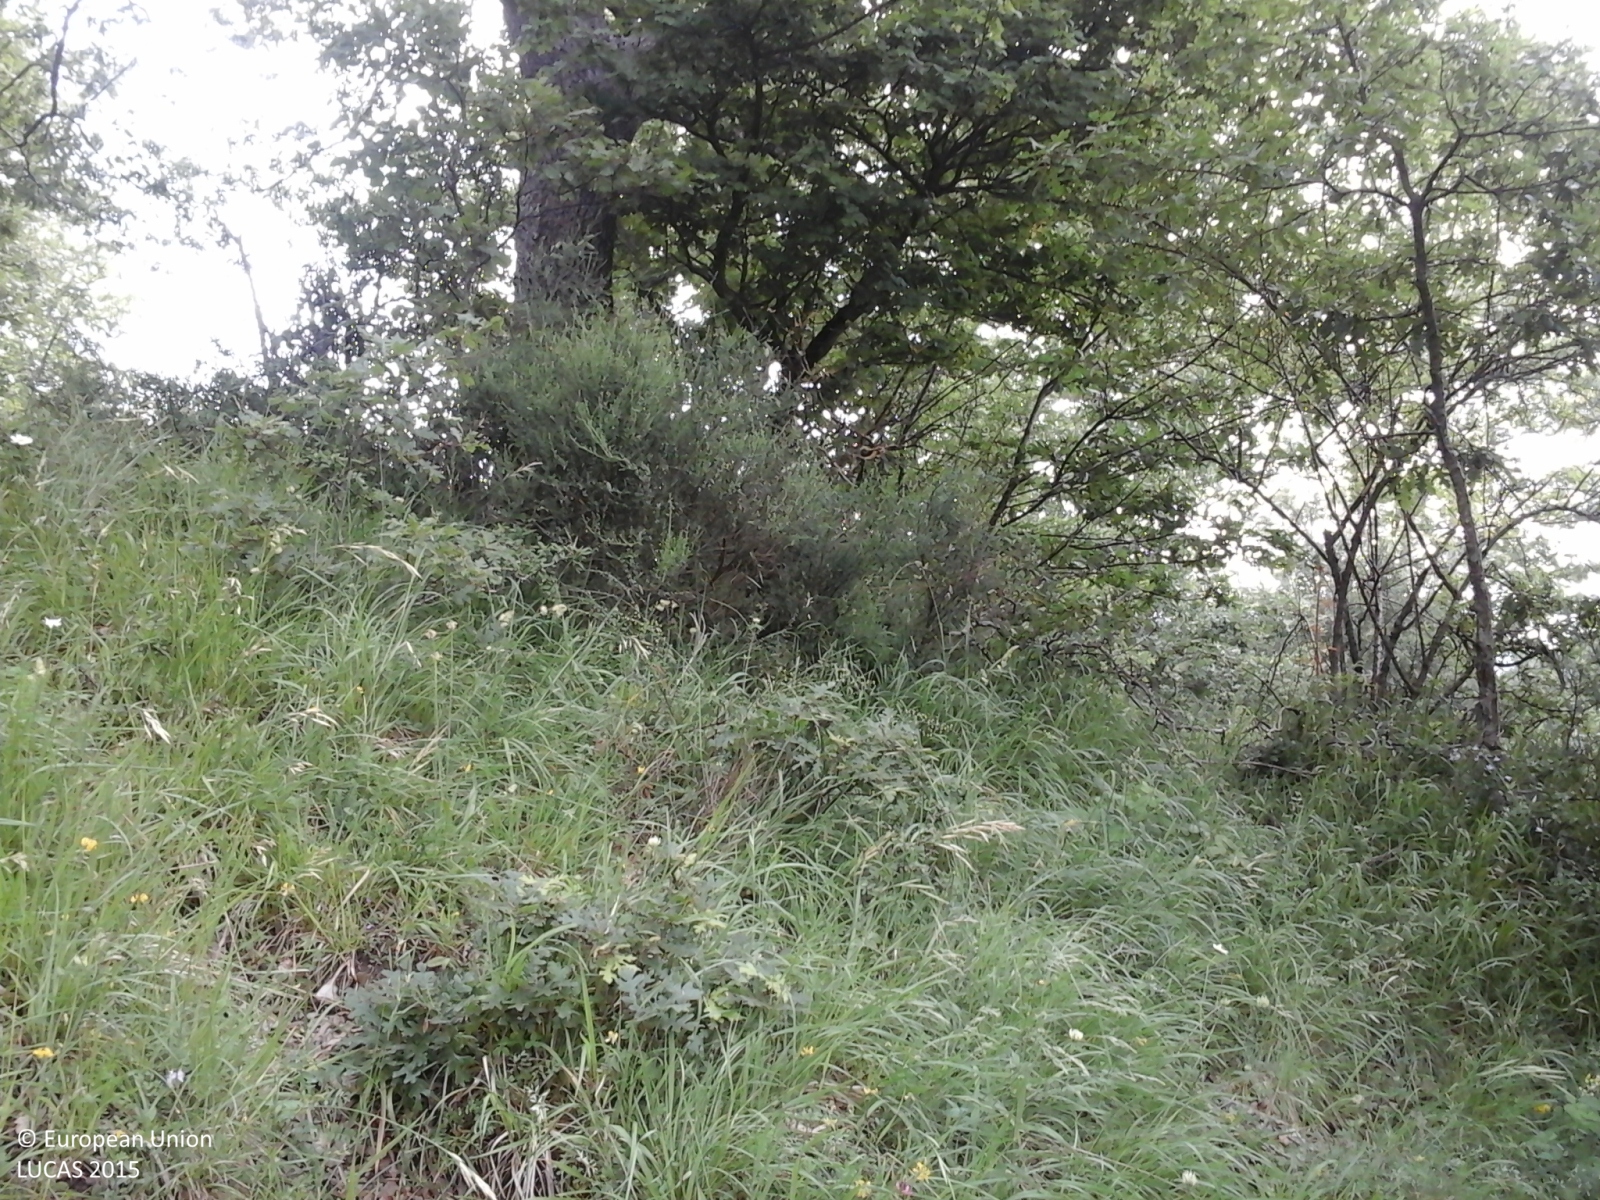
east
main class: Woodland
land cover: Broadleaved woodland
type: thermophilous deciduous forest
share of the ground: > 75 %
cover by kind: broadleaved forest trees 80 %, coniferous forest trees 10 %, shrubs 10 %
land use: Forestry
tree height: > 5 m
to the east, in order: Broadleaved woodland; Shrubland with sparse tree cover; Grassland without tree/shrub cover; Broadleaved woodland; Grassland without tree/shrub cover; Abandoned hedges; Fences; Grassland without tree/shrub cover; Fences; Grassland without tree/shrub cover; Fences; Potatoes; Fences; Broadleaved woodland
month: June
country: IT
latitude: 43.7919
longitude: 11.8966
